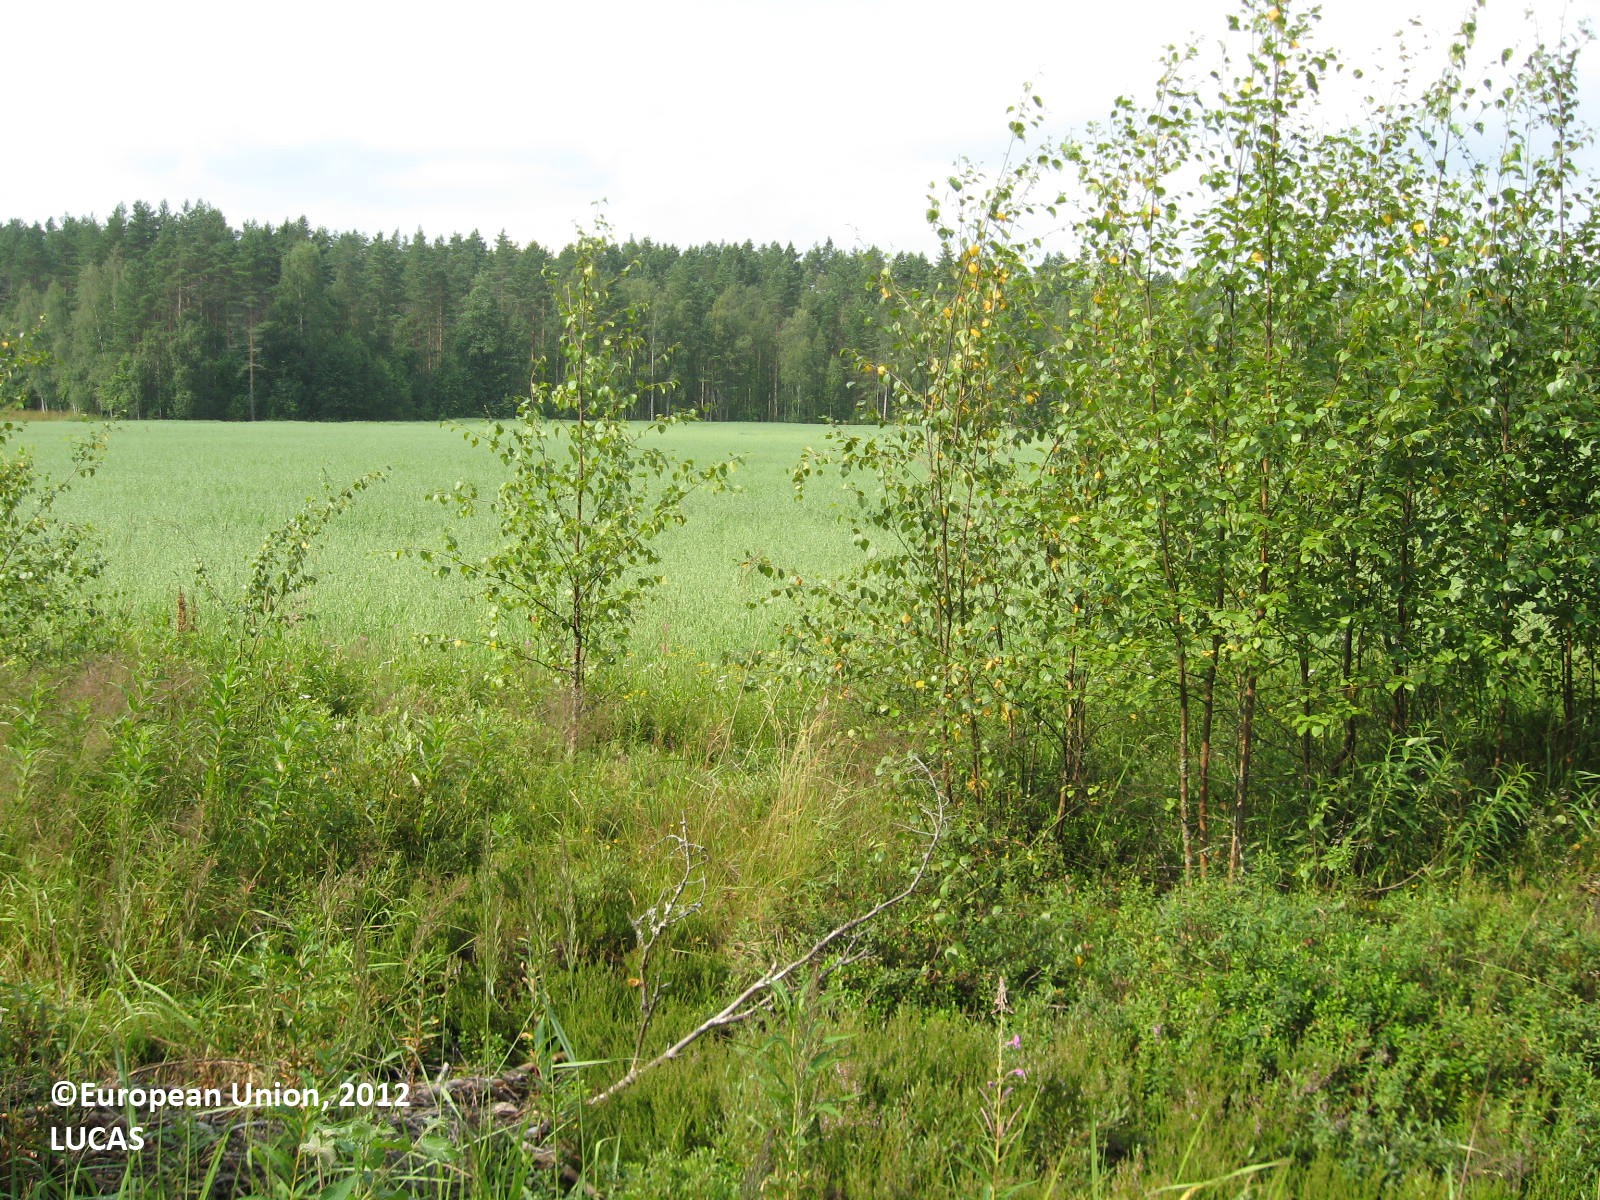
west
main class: Woodland
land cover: Other mixed woodland
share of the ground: 50 - 75 %
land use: Energy production
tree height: < 5 m
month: July
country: FI
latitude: 61.9518
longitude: 22.3927
